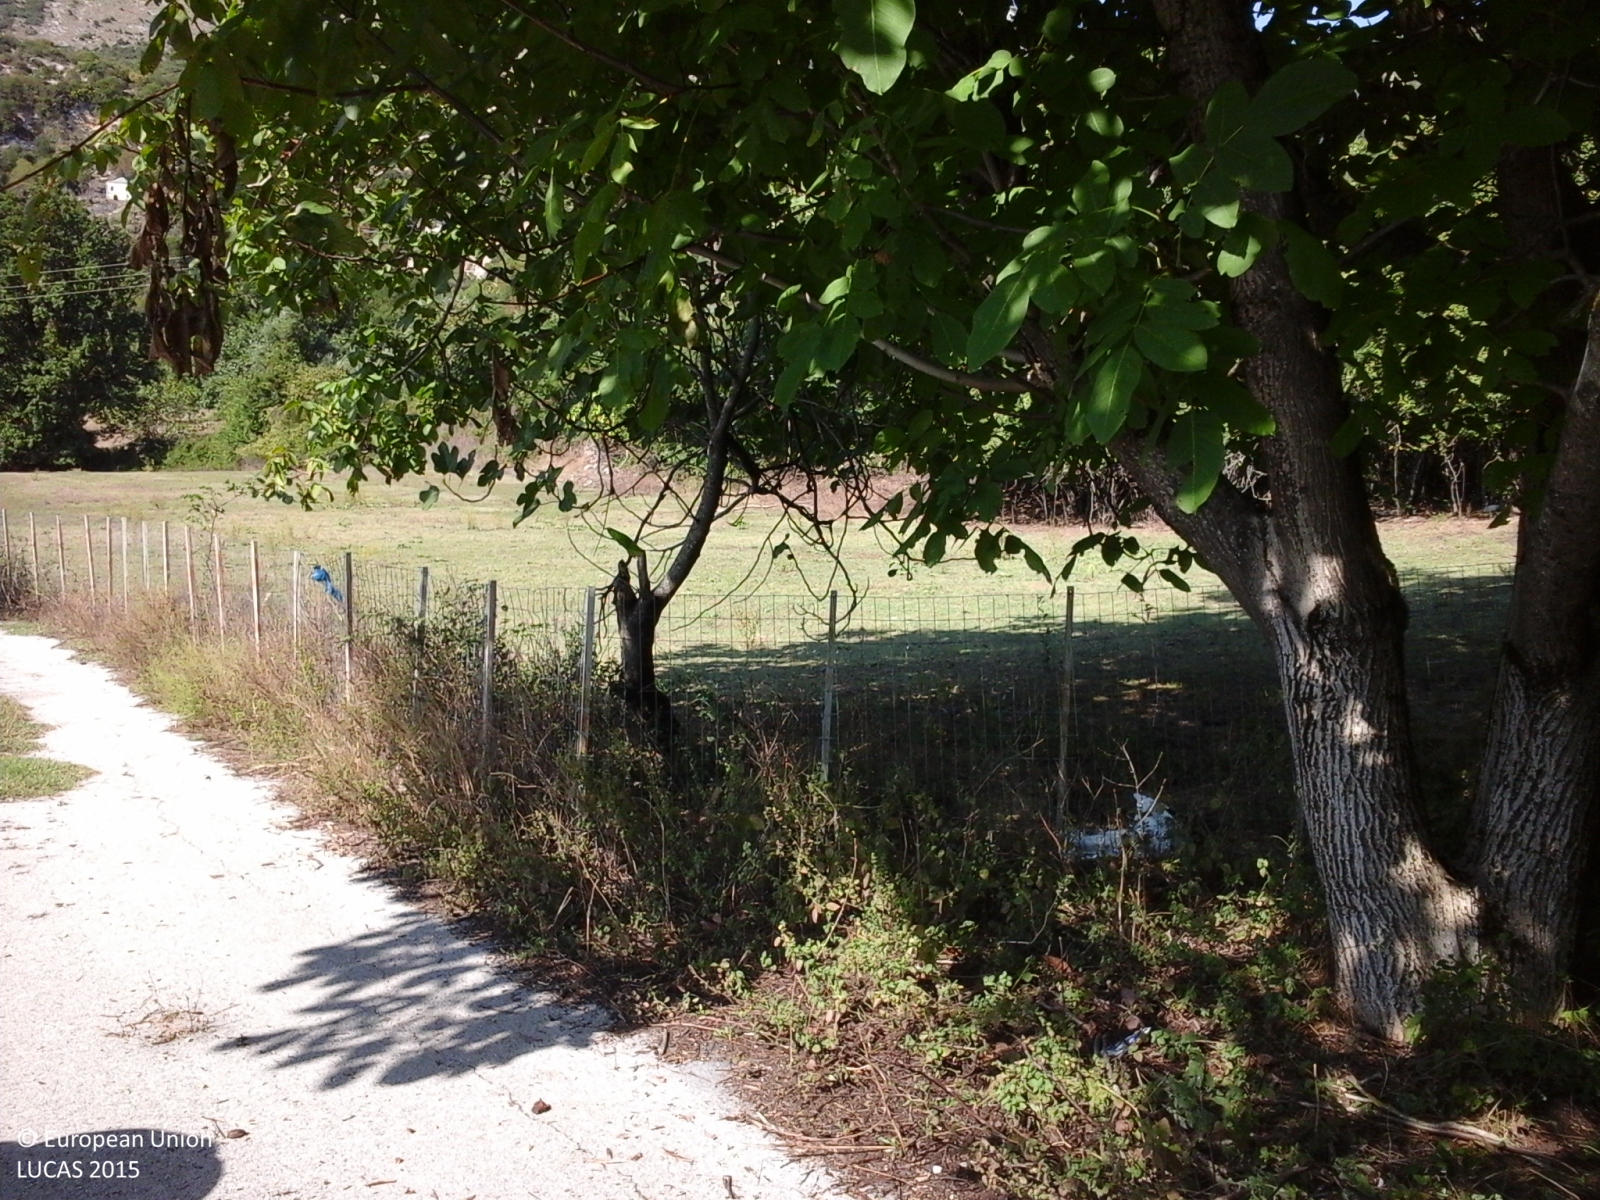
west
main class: Shrubland
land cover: Shrubland with sparse tree cover
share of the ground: > 75 %
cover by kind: shrubs 90 %, broadleaved forest trees 5 %, herbaceous plants 5 %
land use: Semi-natural and natural areas not in use
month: September
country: GR
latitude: 39.5505
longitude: 20.5541
